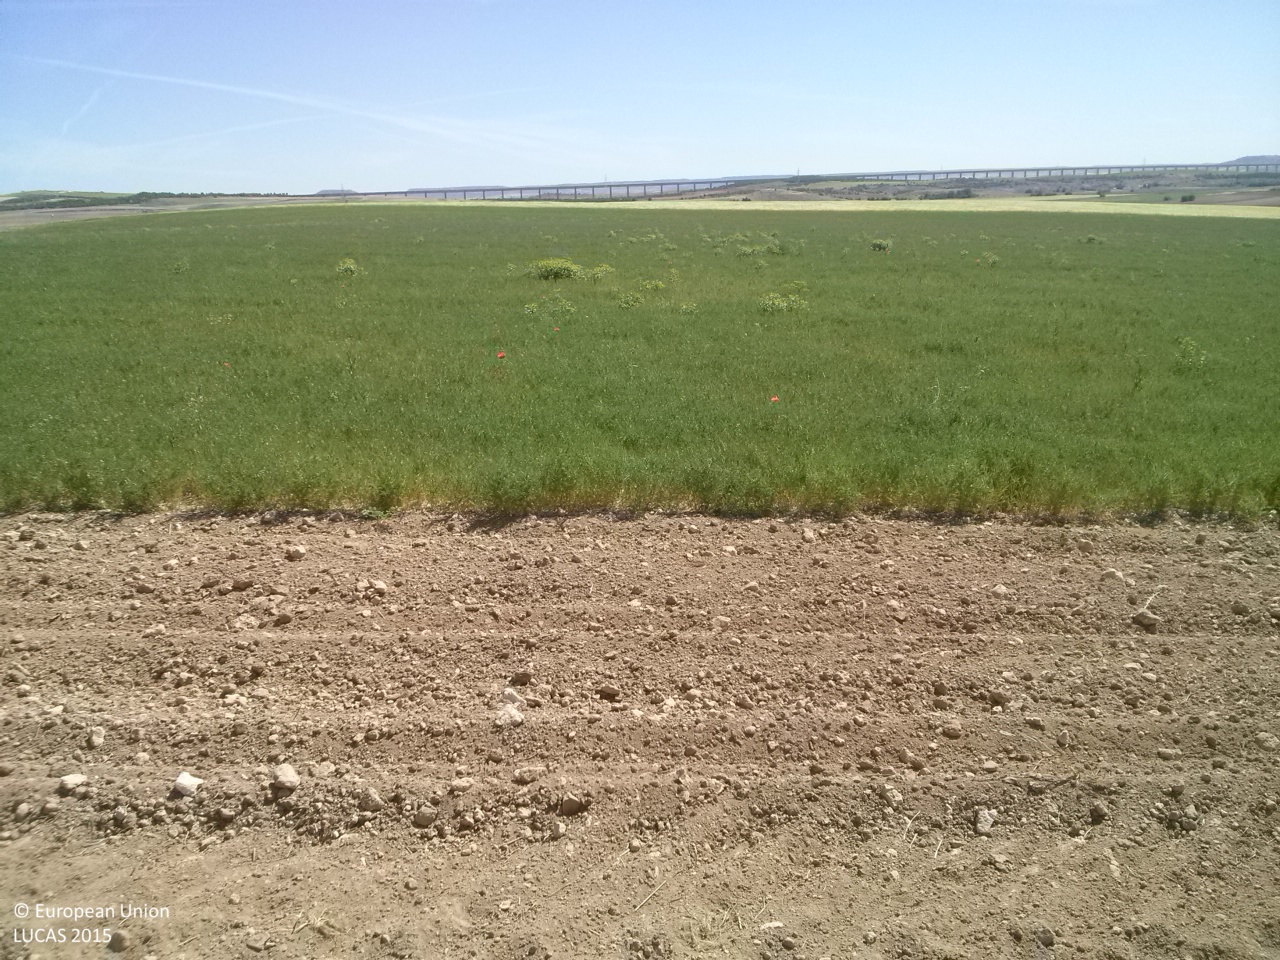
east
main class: Cropland
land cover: Sunflower
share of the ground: < 10 %
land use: Agriculture (excluding fallow land and kitchen gardens)
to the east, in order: Sunflower; Dry pulses; Barley
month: May
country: ES
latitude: 39.9450
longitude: -2.7423
